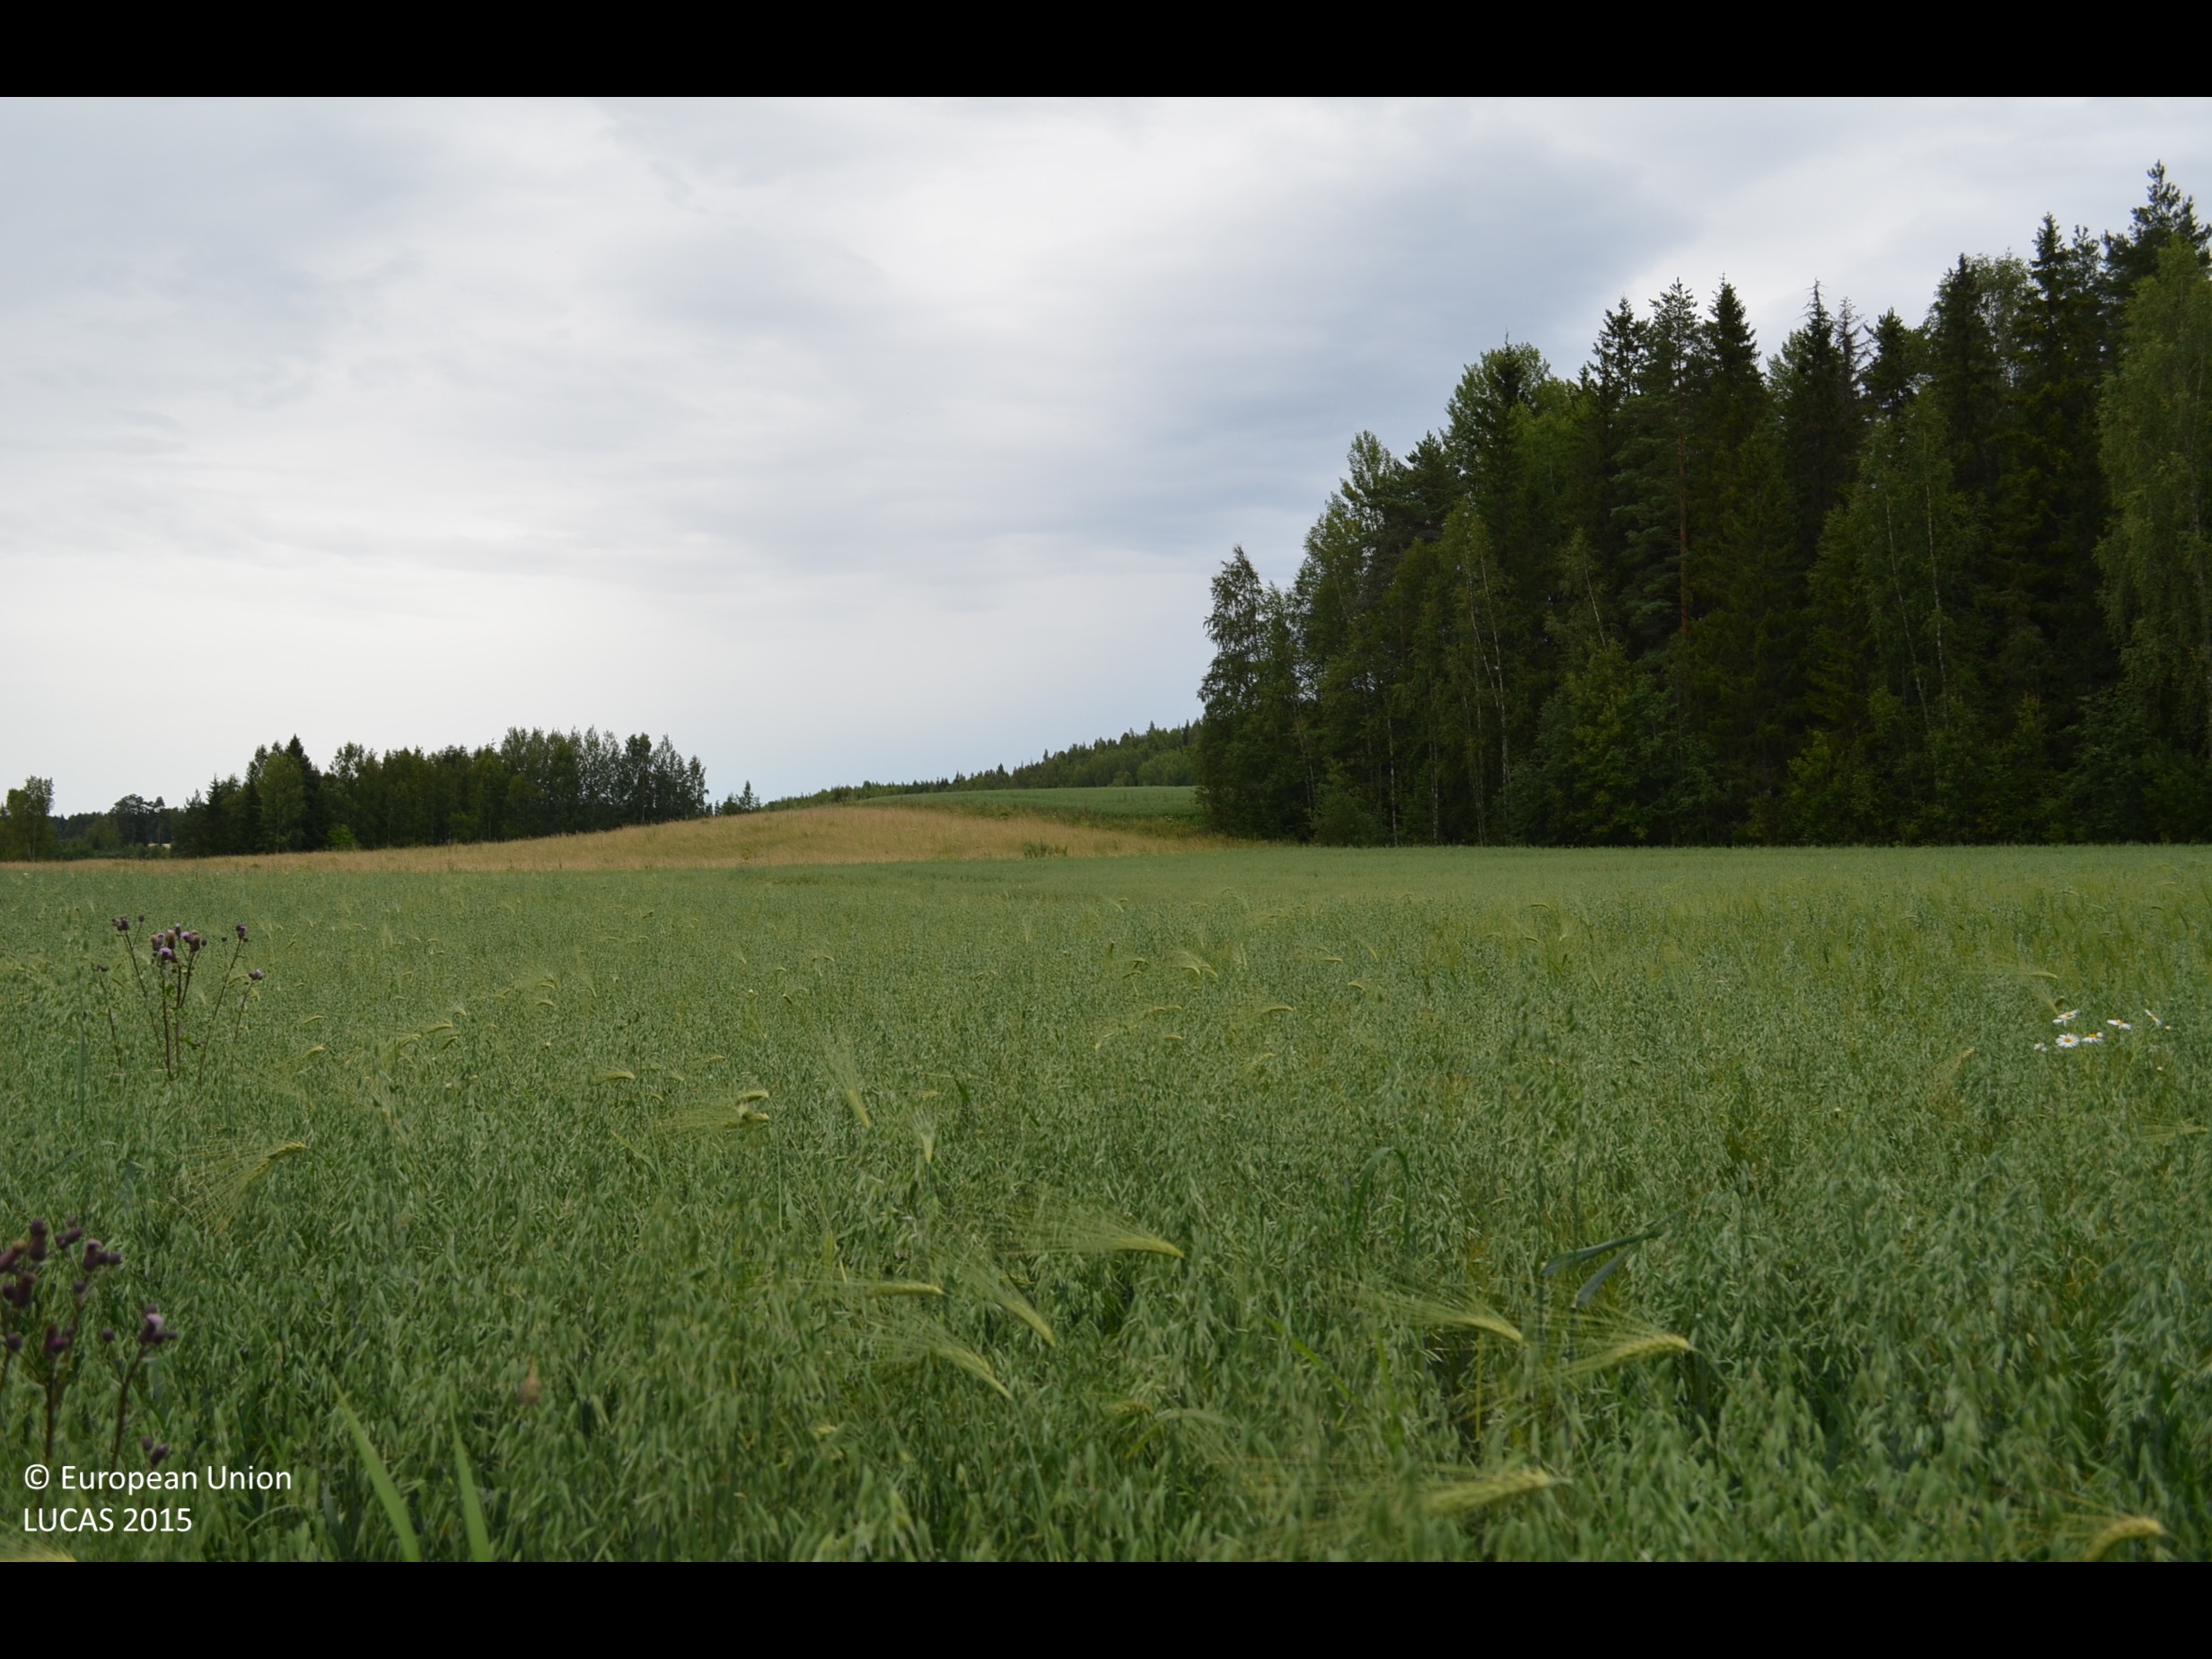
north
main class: Cropland
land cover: Mixed cereals for fodder
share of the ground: > 75 %
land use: Agriculture (excluding fallow land and kitchen gardens)
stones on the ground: < 10 %
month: August
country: FI
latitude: 61.5668
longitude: 23.2345
